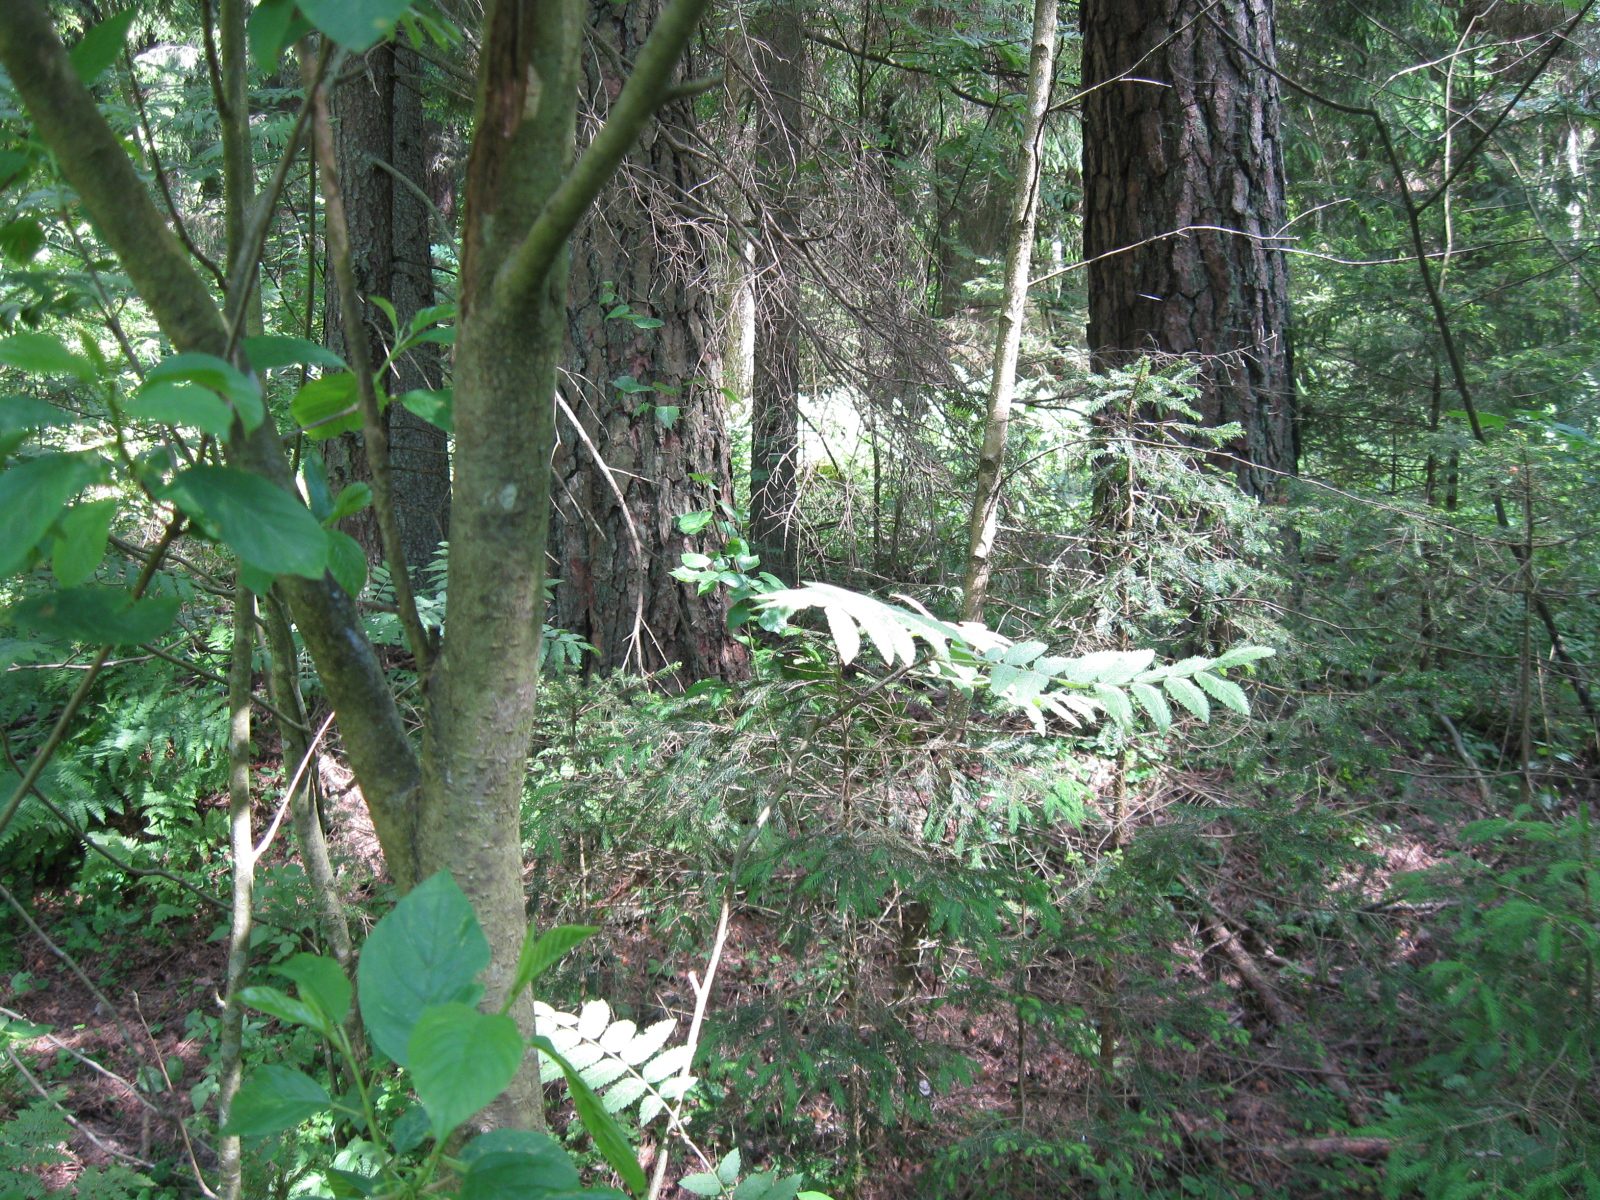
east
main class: Woodland
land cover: Spruce dominated mixed woodland
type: hemiboreal forest and nemoral coniferous forest and mixed broadleaved-coniferous forest
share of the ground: > 75 %
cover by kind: coniferous forest trees 65 %, broadleaved forest trees 30 %, herbaceous plants 5 %
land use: Forestry
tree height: > 5 m
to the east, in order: Spruce dominated mixed woodland; Pine dominated mixed woodland; Spruce dominated coniferous woodland
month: June
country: LT
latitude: 54.6268
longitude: 23.8589
